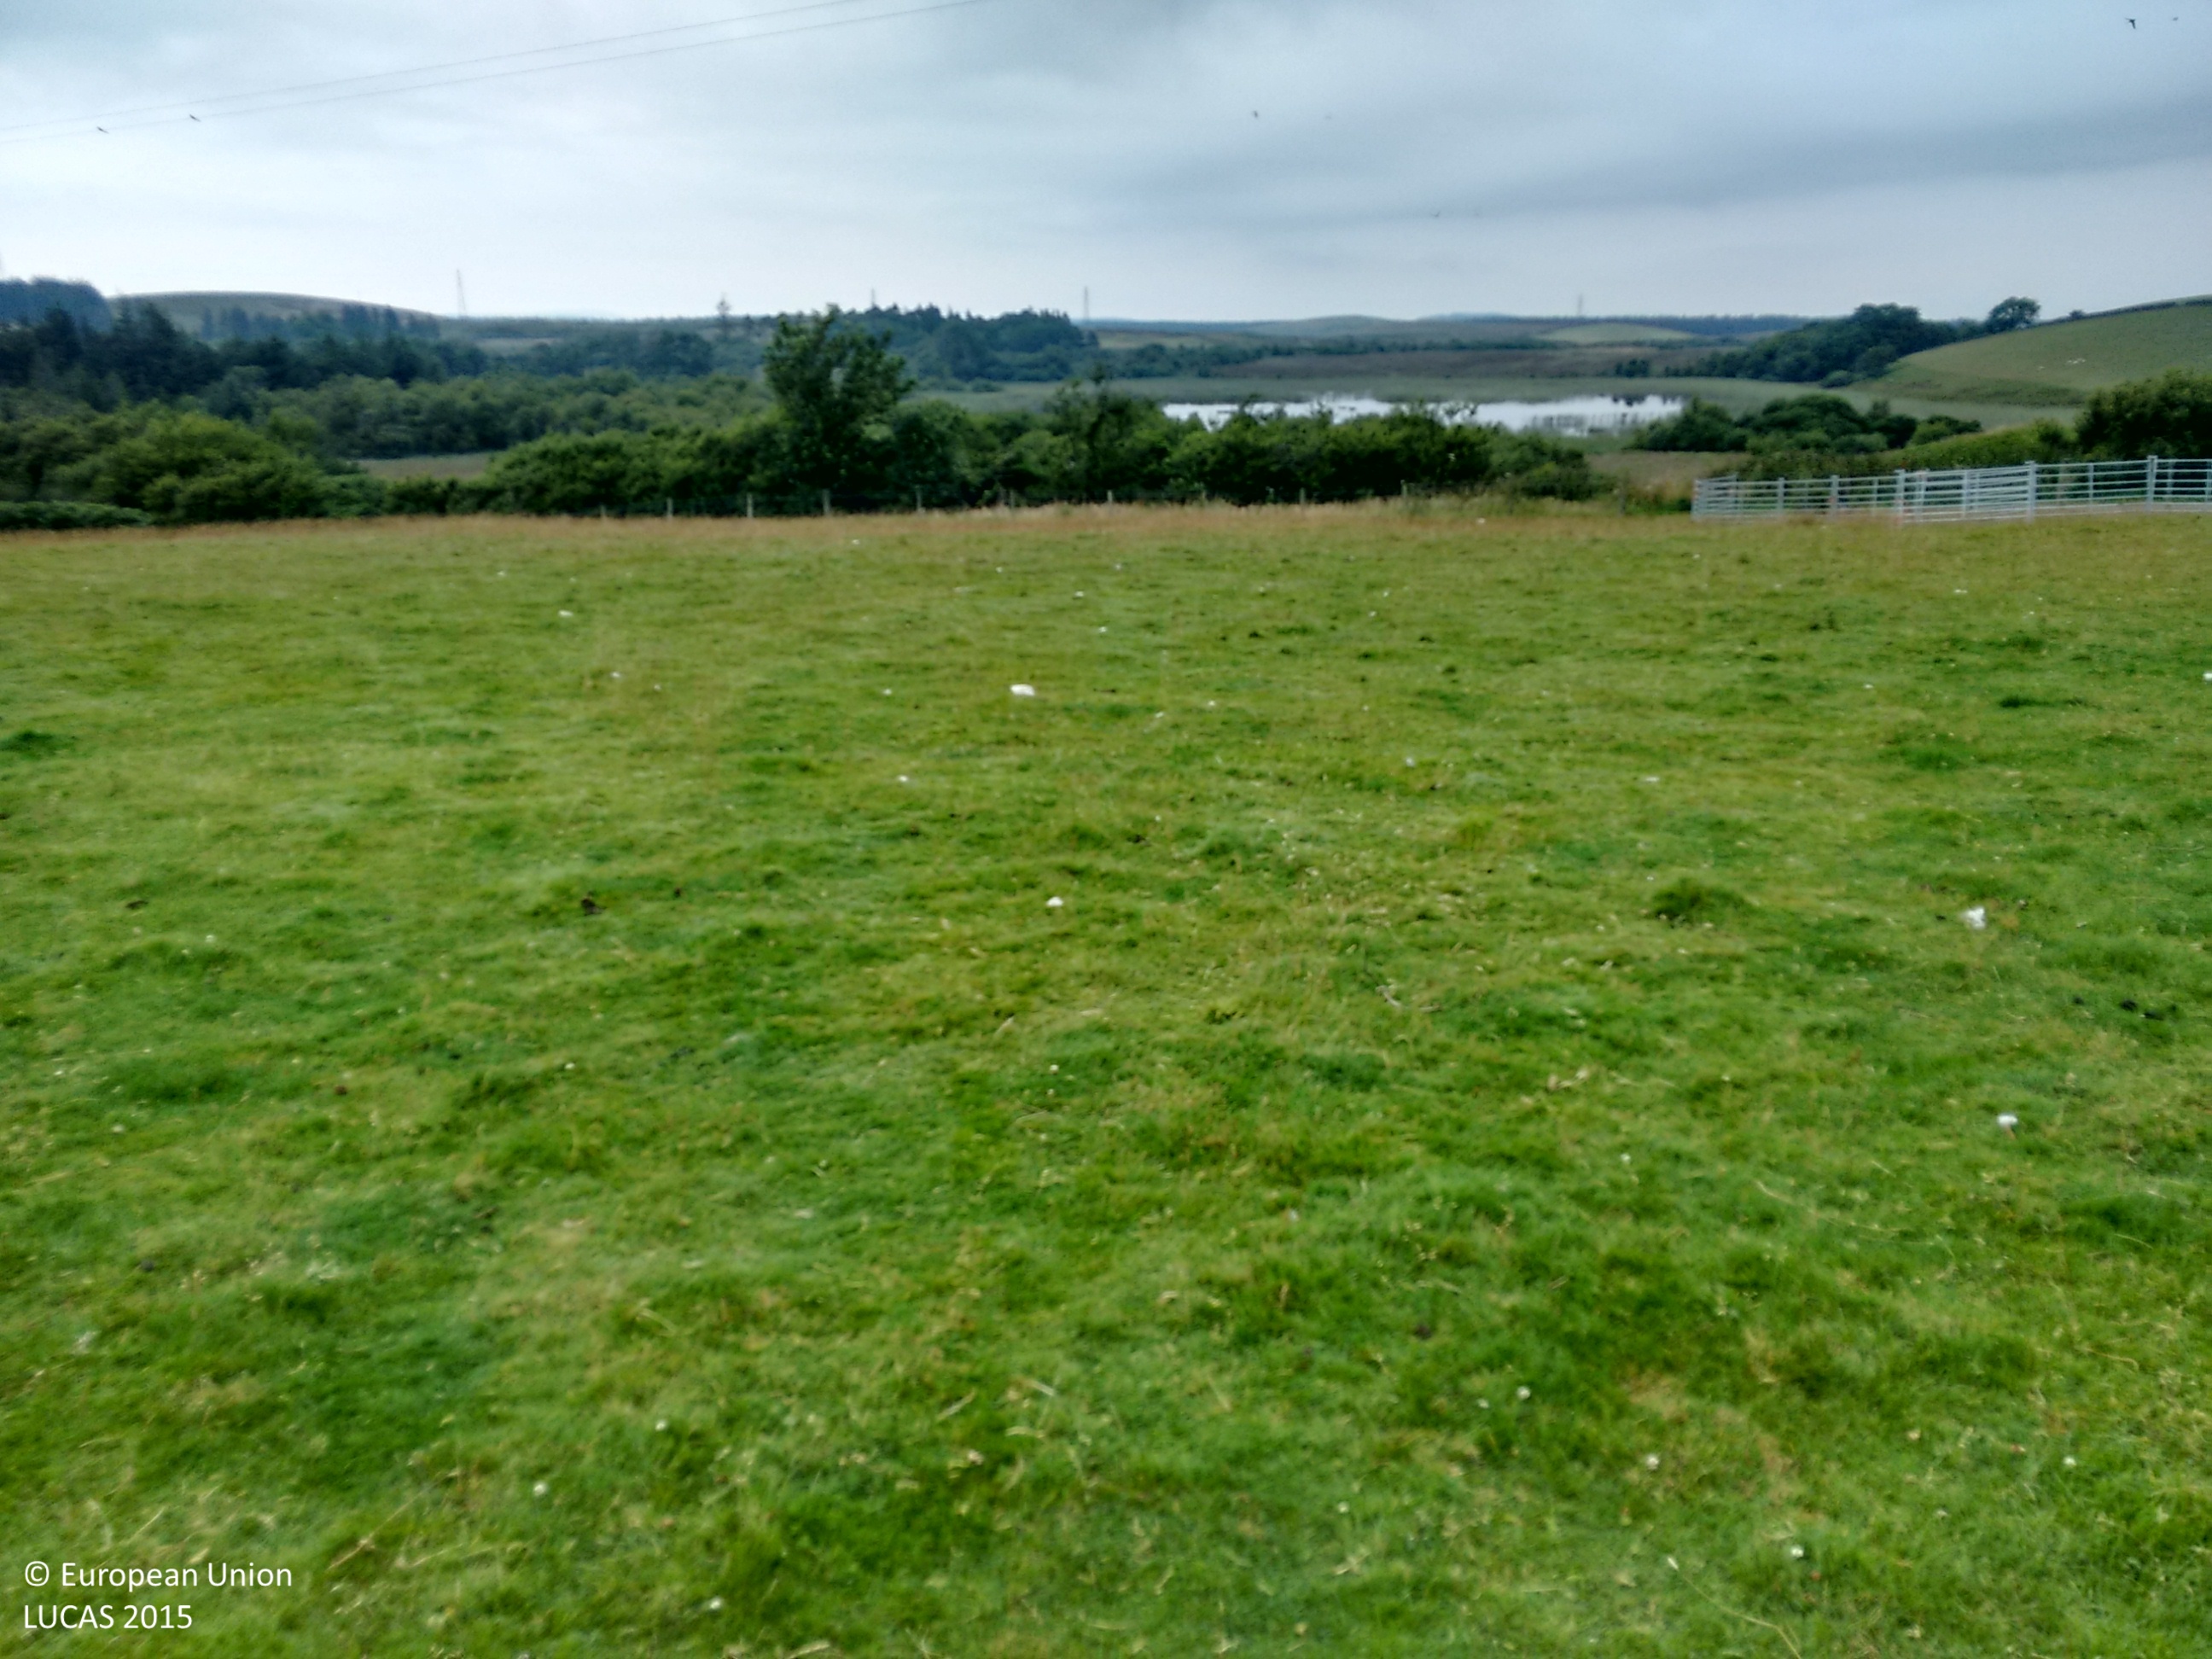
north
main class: Grassland
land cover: Grassland without tree/shrub cover
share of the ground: > 75 %
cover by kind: herbaceous plants 100 %
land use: Agriculture (excluding fallow land and kitchen gardens)
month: August
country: GB
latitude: 54.8932
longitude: -4.7163
